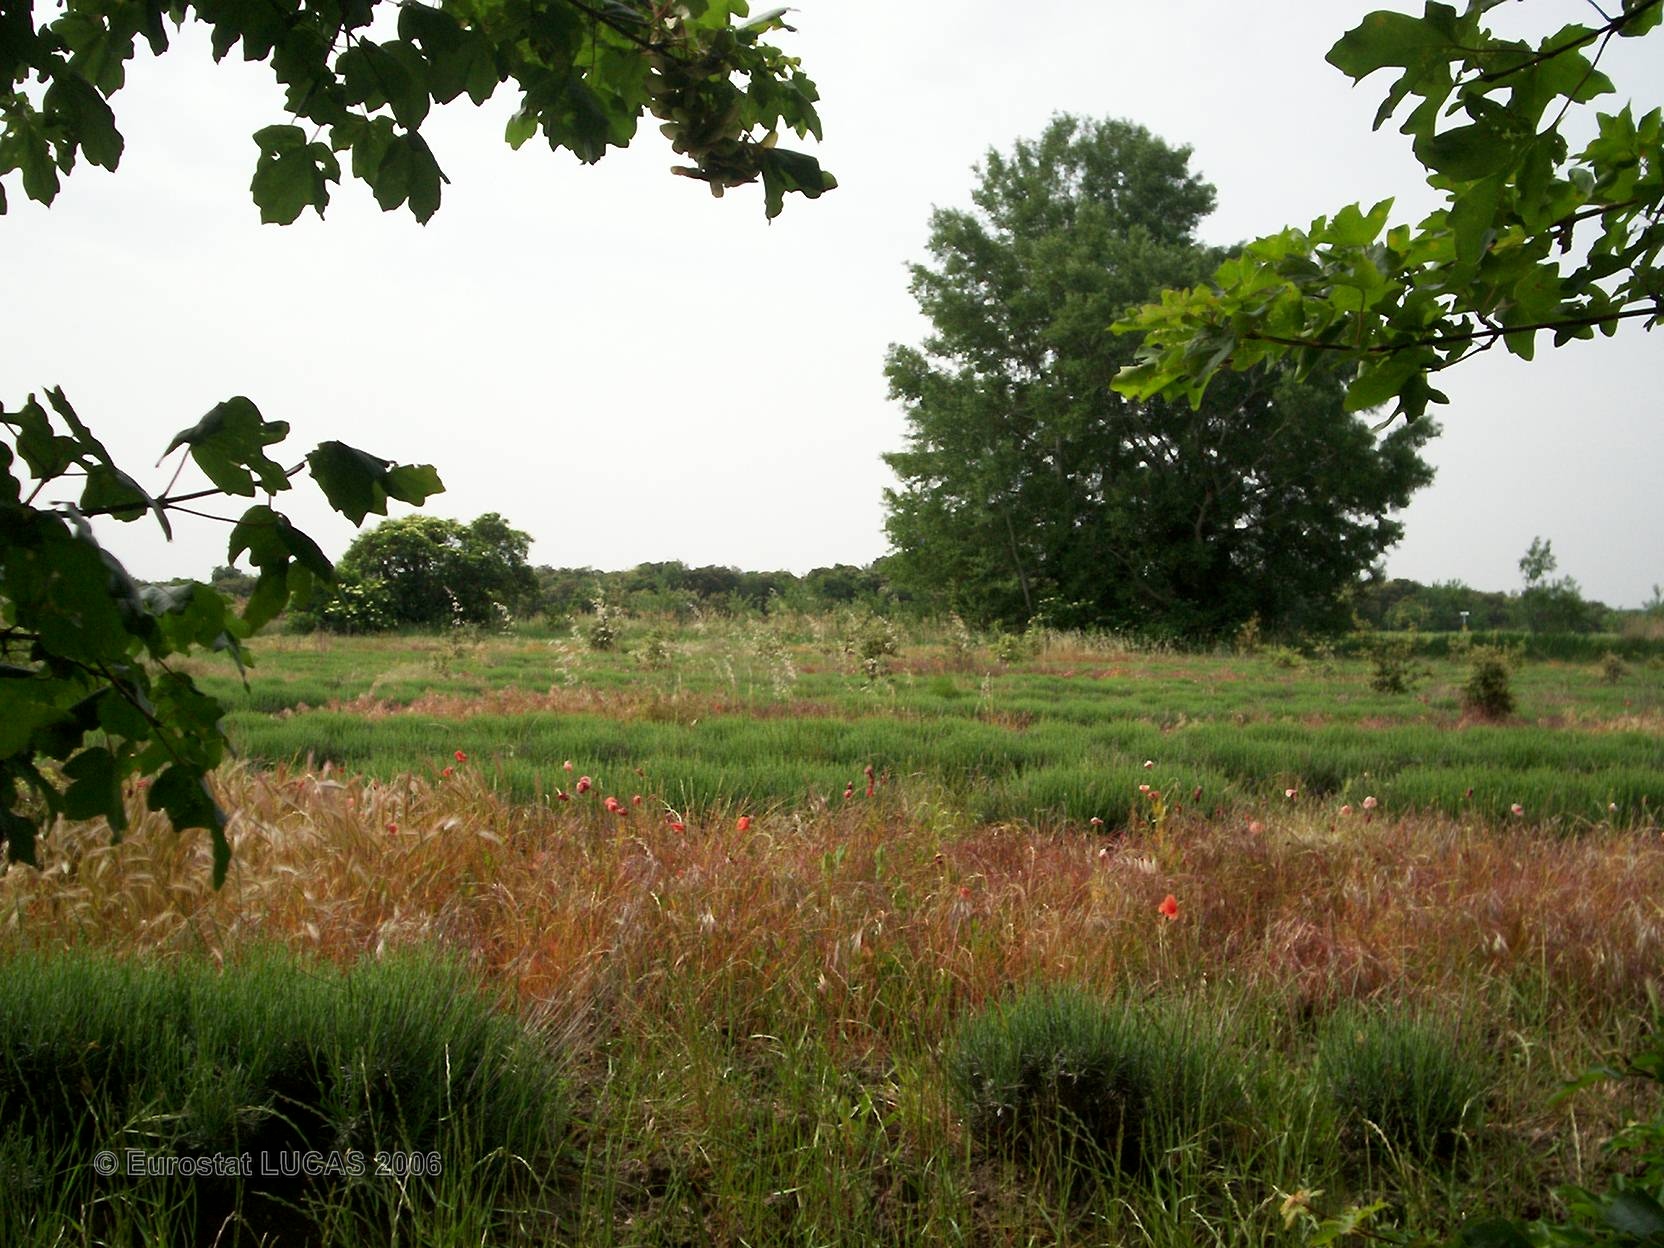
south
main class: Cropland
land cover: Barley
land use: Agriculture (excluding fallow land and kitchen gardens)
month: May
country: FR
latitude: 44.4045
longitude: 4.8716
